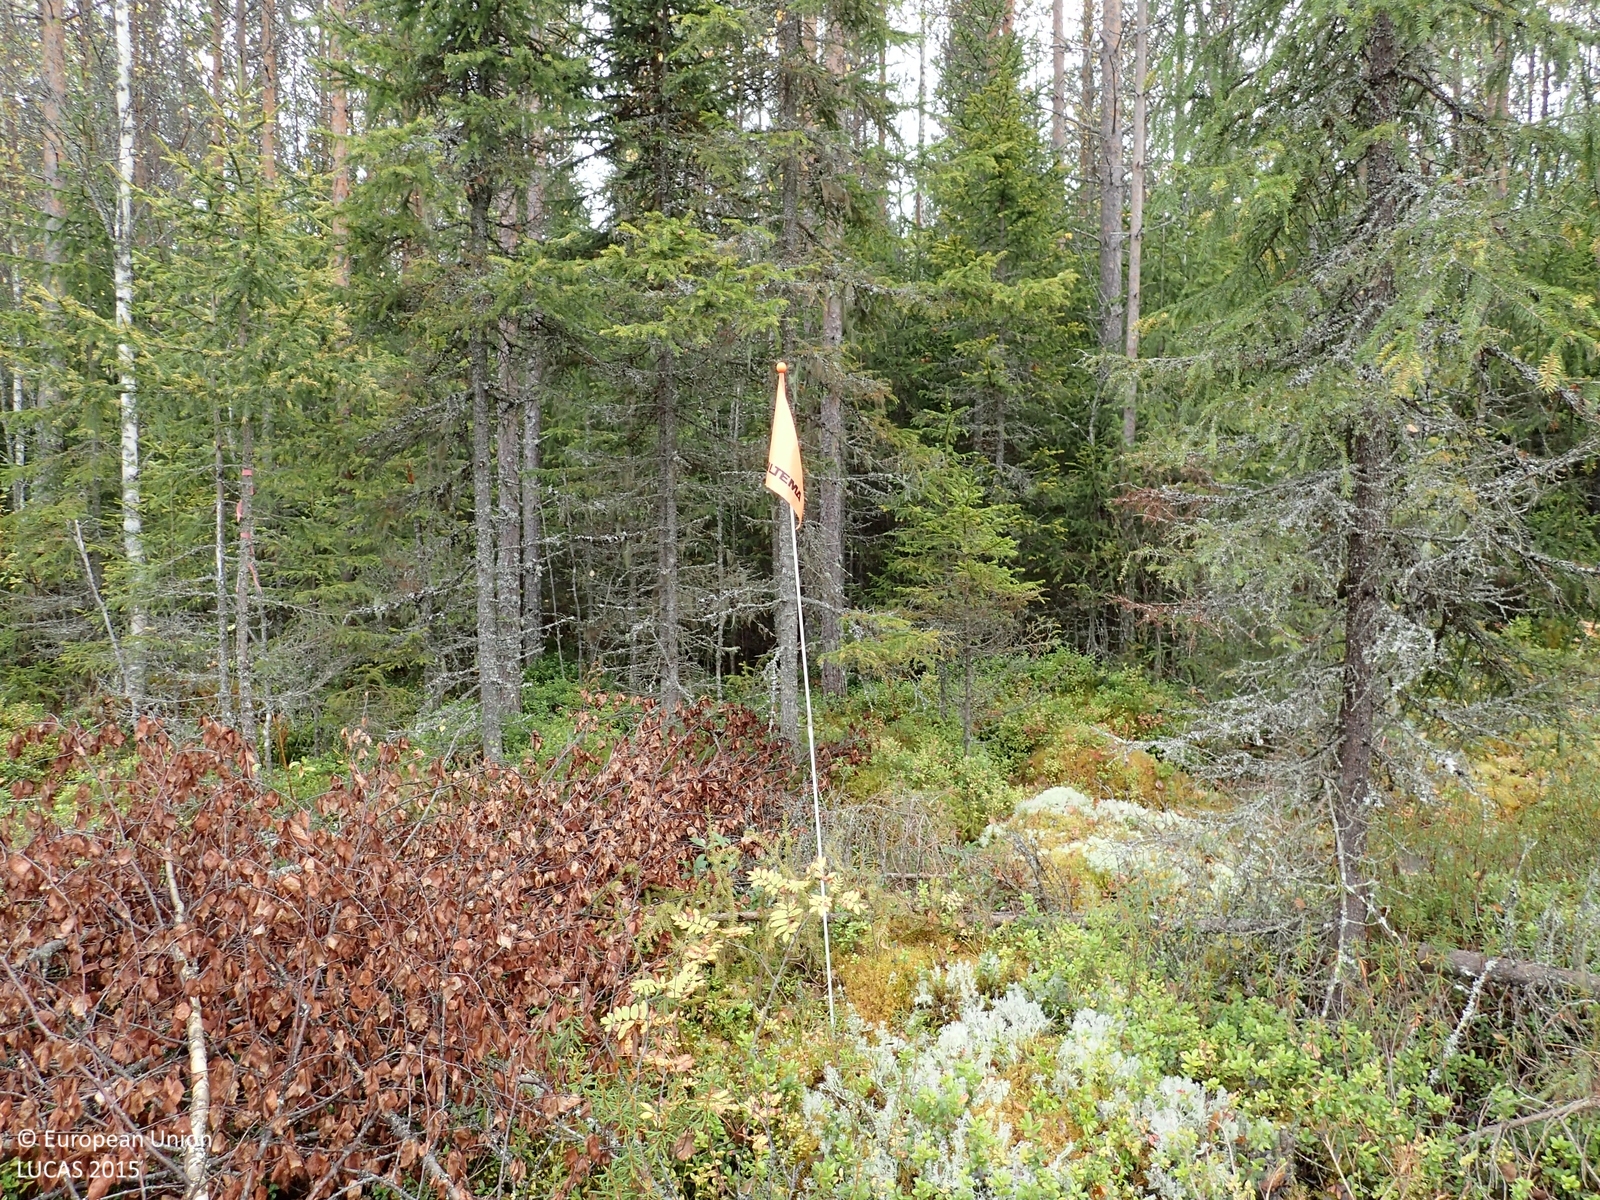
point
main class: Woodland
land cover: Spruce dominated coniferous woodland
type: boreal forest
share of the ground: 50 - 75 %
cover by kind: coniferous forest trees 50 %, shrubs 45 %, lichens and mosses 5 %
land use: Forestry
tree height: < 5 m
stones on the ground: < 10 %
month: September
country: FI
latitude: 63.2874
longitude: 25.2319
